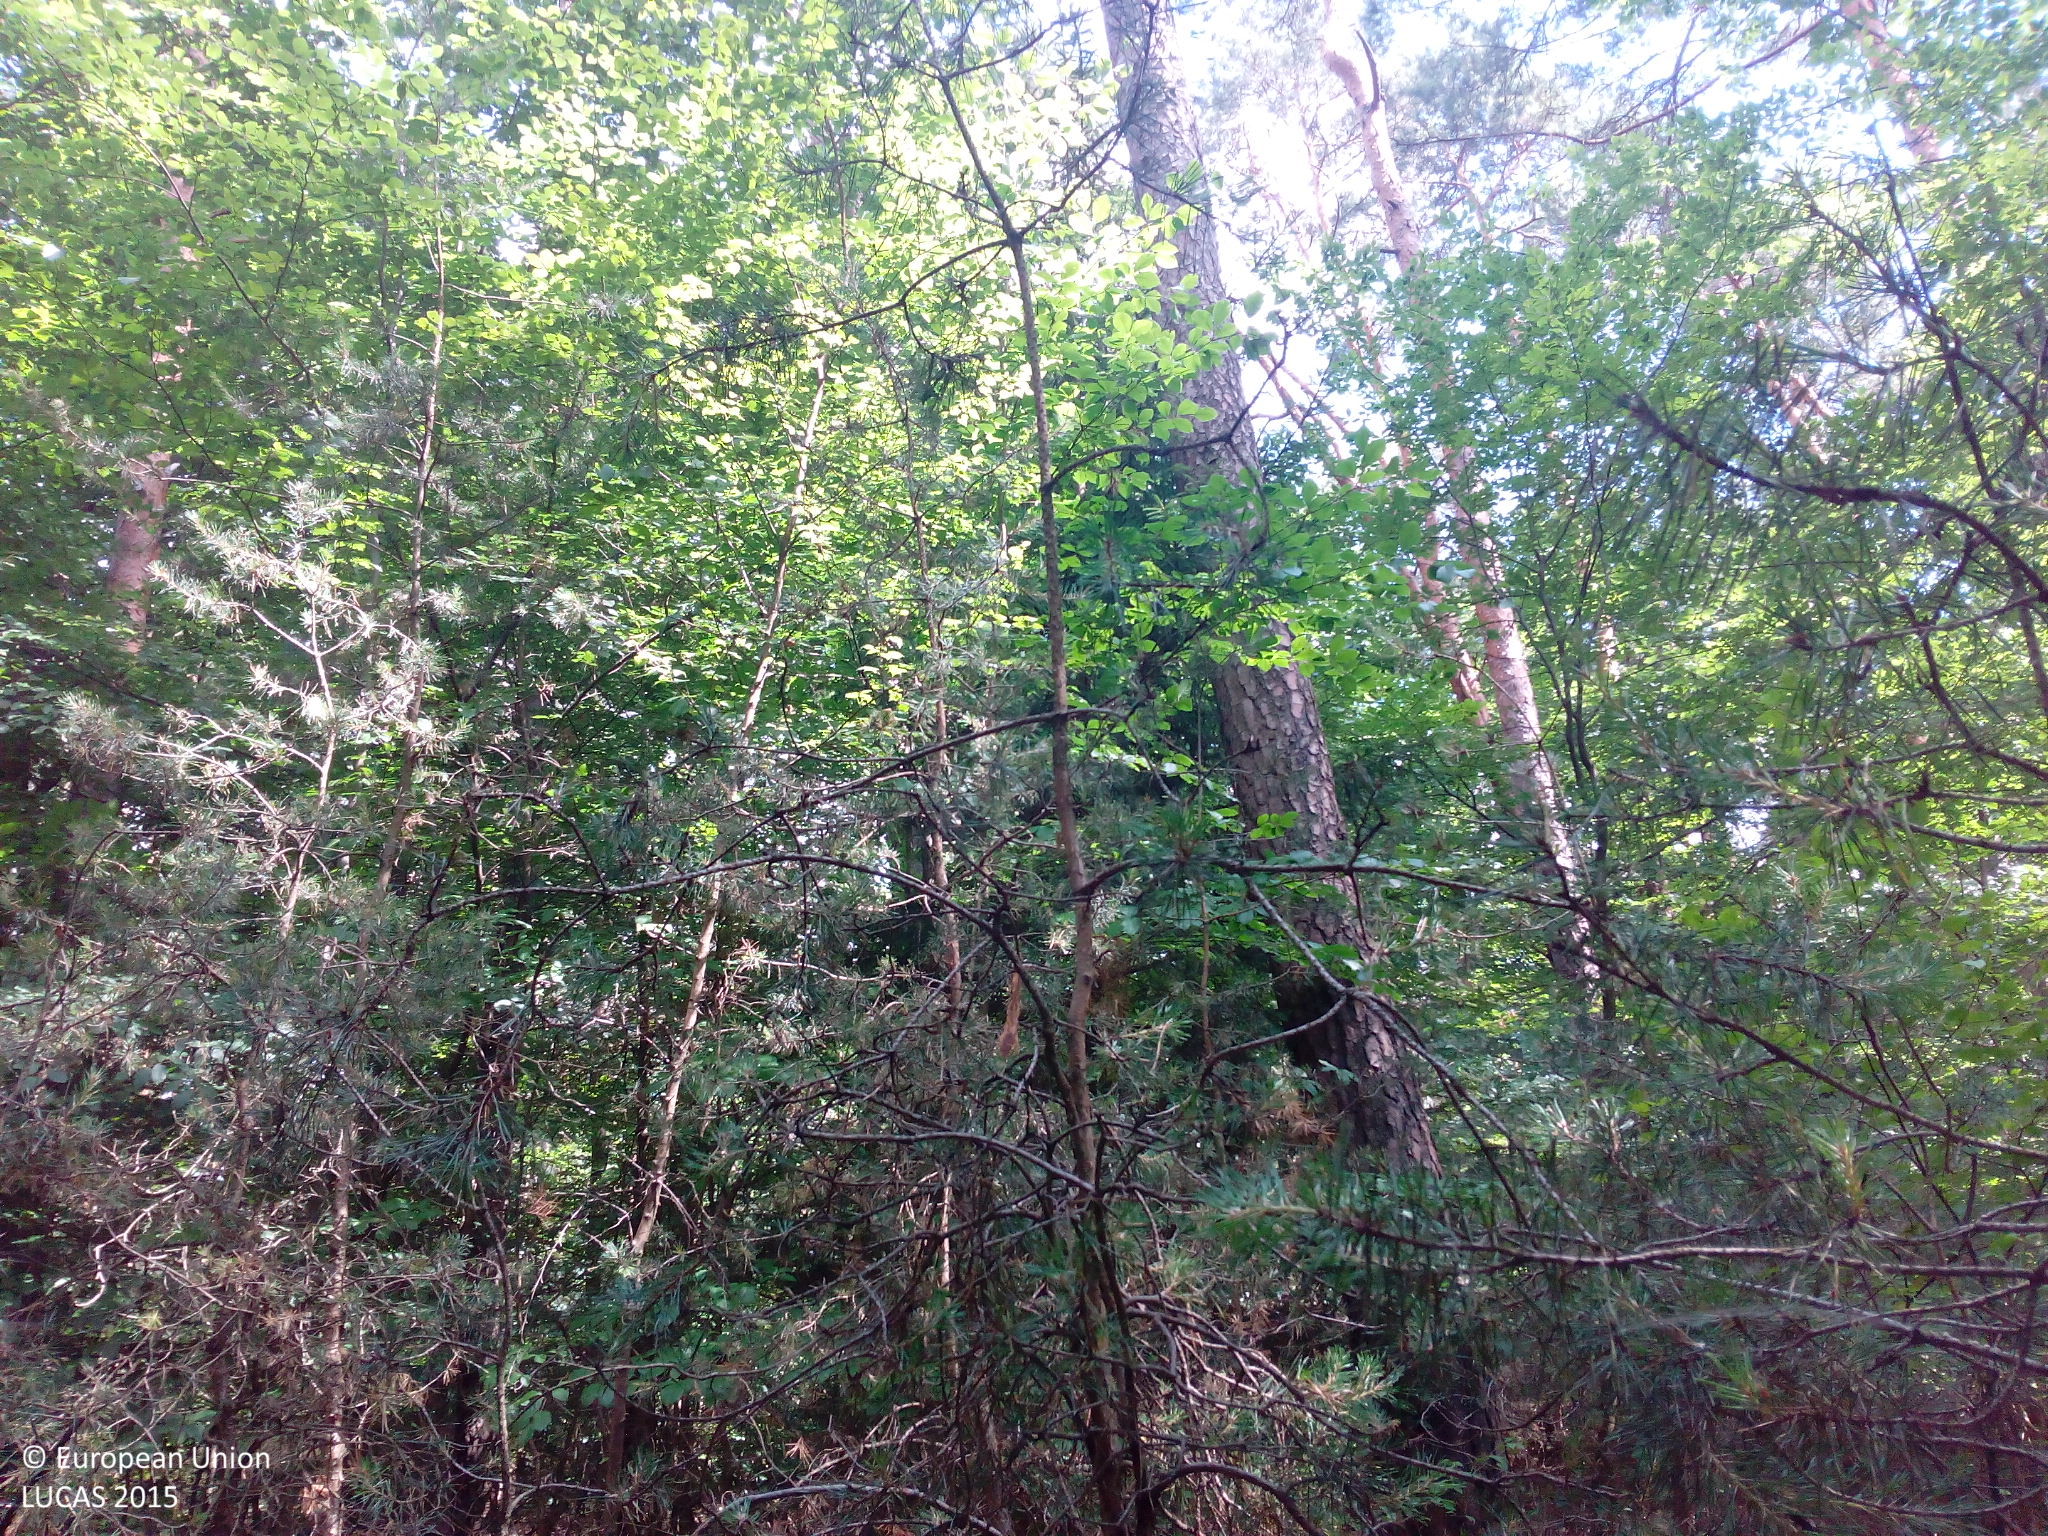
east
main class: Woodland
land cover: Pine dominated mixed woodland
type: hemiboreal forest and nemoral coniferous forest and mixed broadleaved-coniferous forest
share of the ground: > 75 %
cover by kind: broadleaved forest trees 70 %, coniferous forest trees 25 %, unconsolidated bare surface 5 %
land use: Forestry
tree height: > 5 m
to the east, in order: Pine dominated mixed woodland; Tracks; Pine dominated coniferous woodland; Tracks; Pine dominated mixed woodland; Tracks; Pine dominated mixed woodland
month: June
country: DE
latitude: 49.5380
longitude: 8.0521
